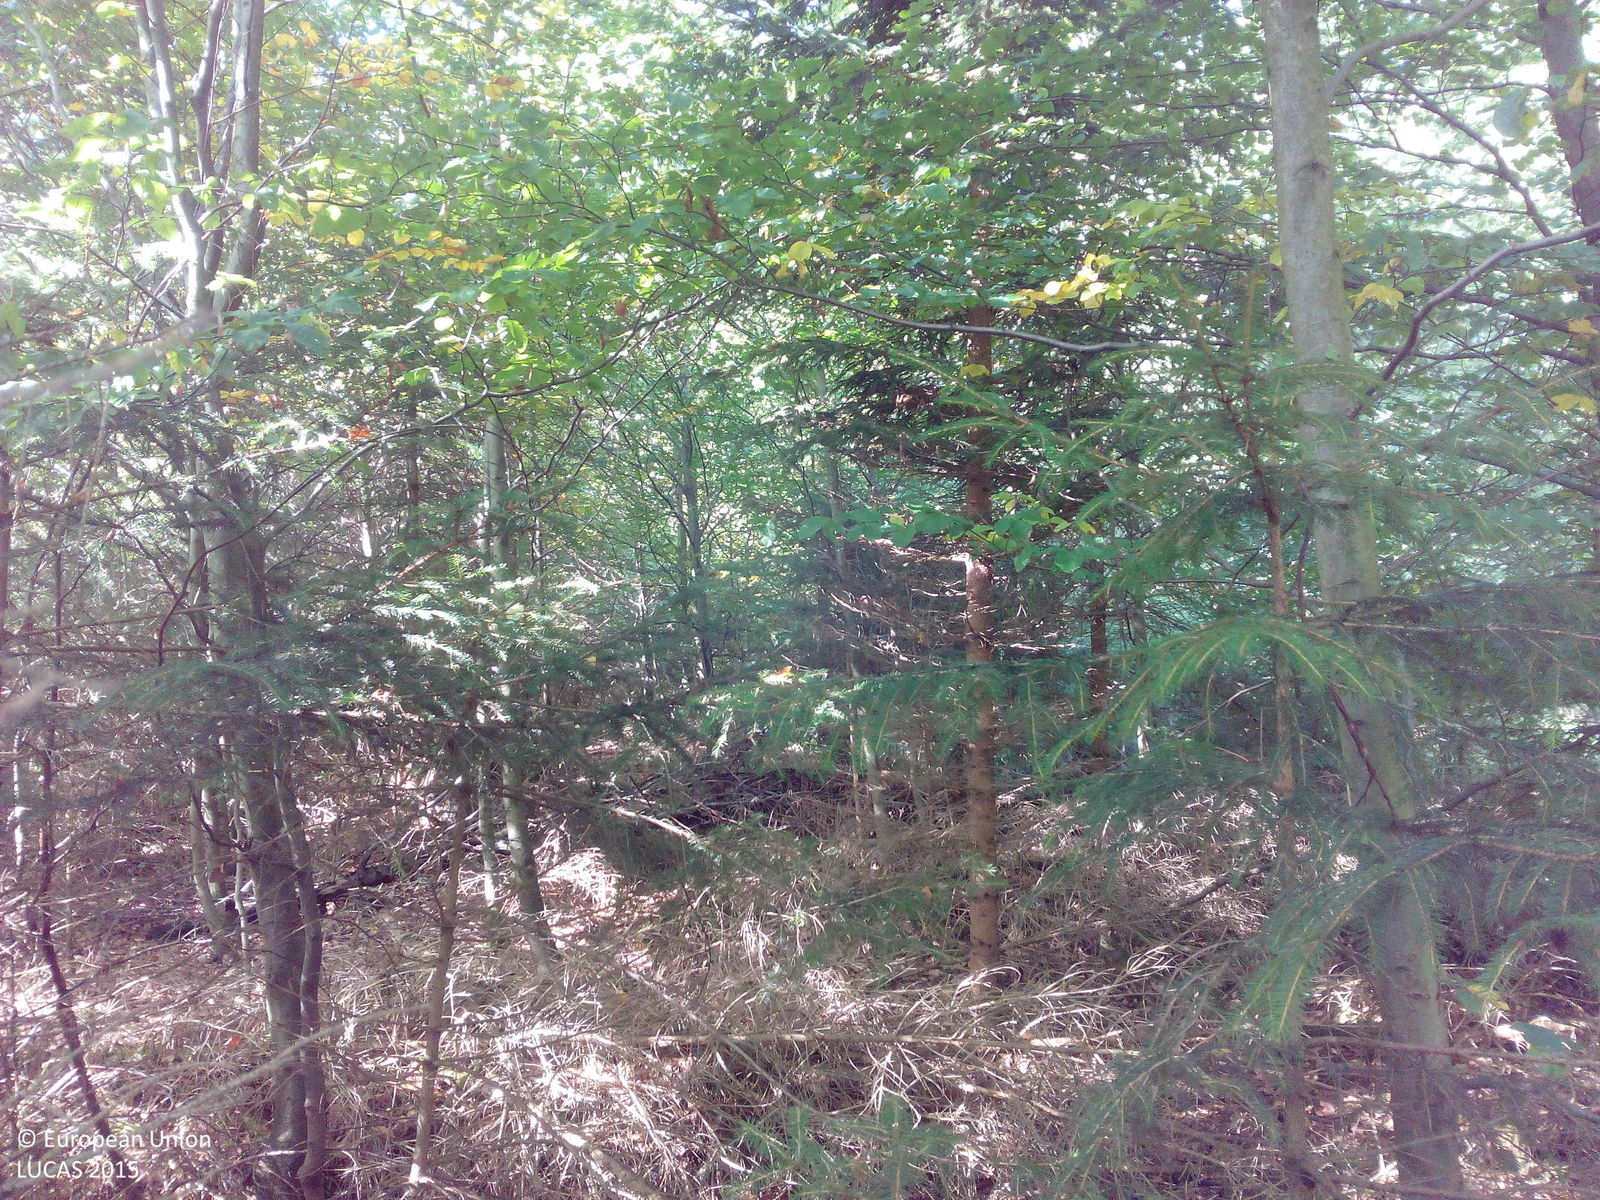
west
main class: Woodland
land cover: Spruce dominated coniferous woodland
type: hemiboreal forest and nemoral coniferous forest and mixed broadleaved-coniferous forest
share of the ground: > 75 %
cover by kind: coniferous forest trees 90 %, broadleaved forest trees 10 %
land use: Forestry
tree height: > 5 m
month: September
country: DE
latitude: 51.7837
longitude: 9.6377
